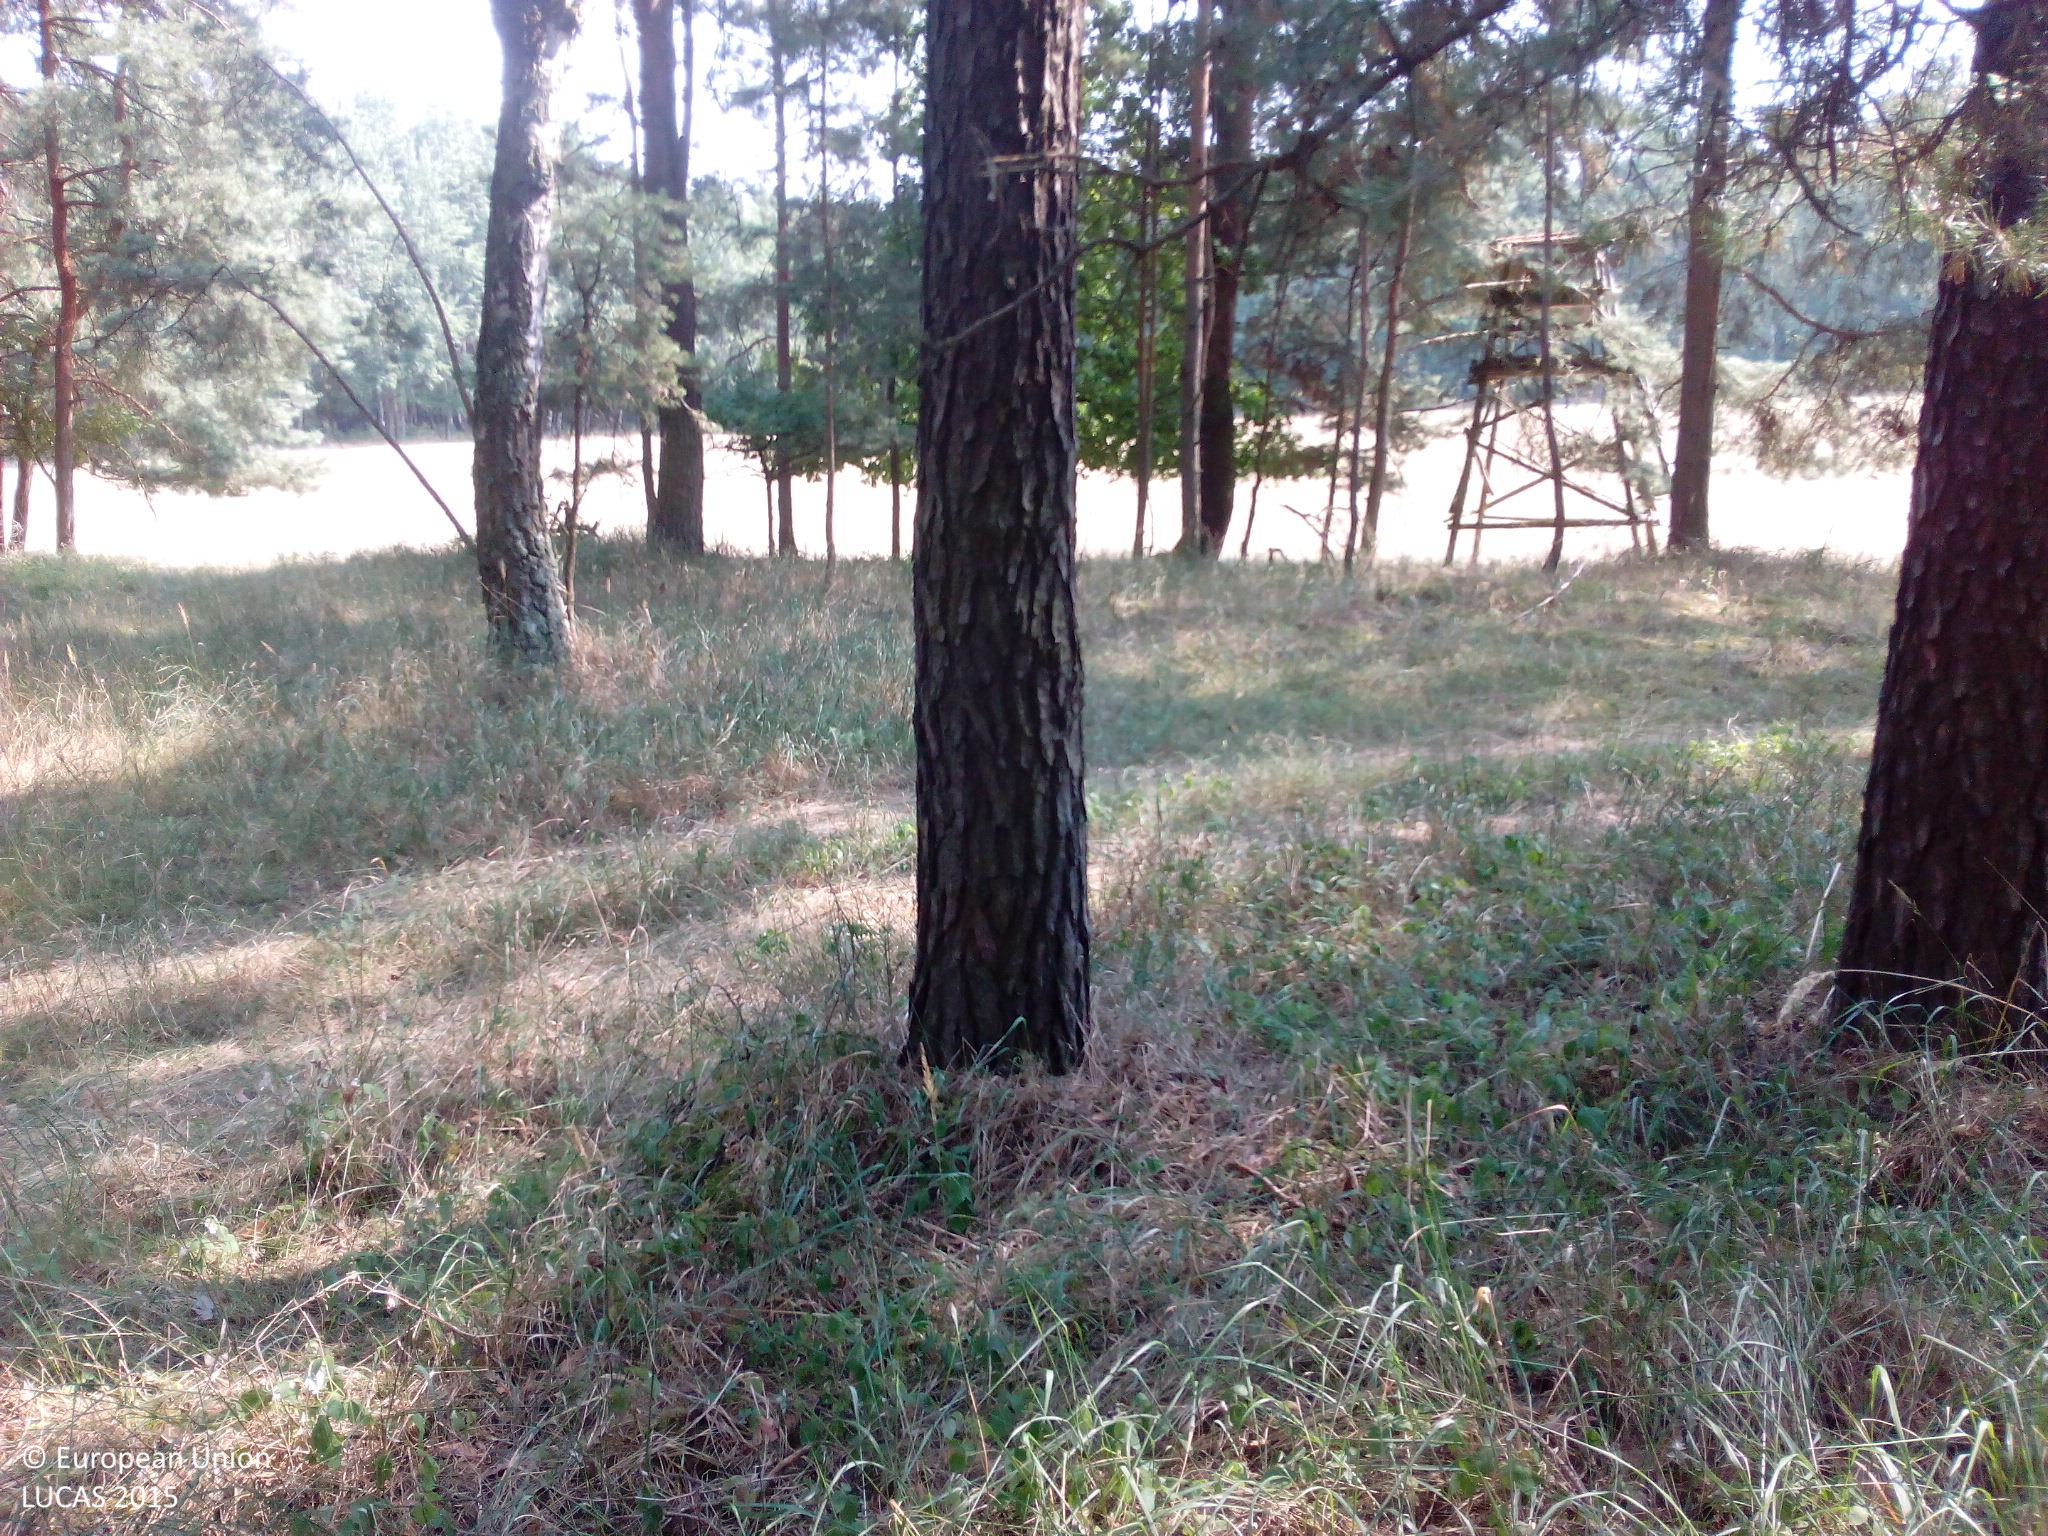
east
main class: Woodland
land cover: Pine dominated coniferous woodland
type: hemiboreal forest and nemoral coniferous forest and mixed broadleaved-coniferous forest
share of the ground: > 75 %
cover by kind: coniferous forest trees 95 %, herbaceous plants 5 %
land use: Forestry
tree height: > 5 m
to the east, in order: Pine dominated coniferous woodland; Grassland without tree/shrub cover; Pine dominated mixed woodland; Tracks; Pine dominated mixed woodland
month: August
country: DE
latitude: 51.7563
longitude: 12.5640
